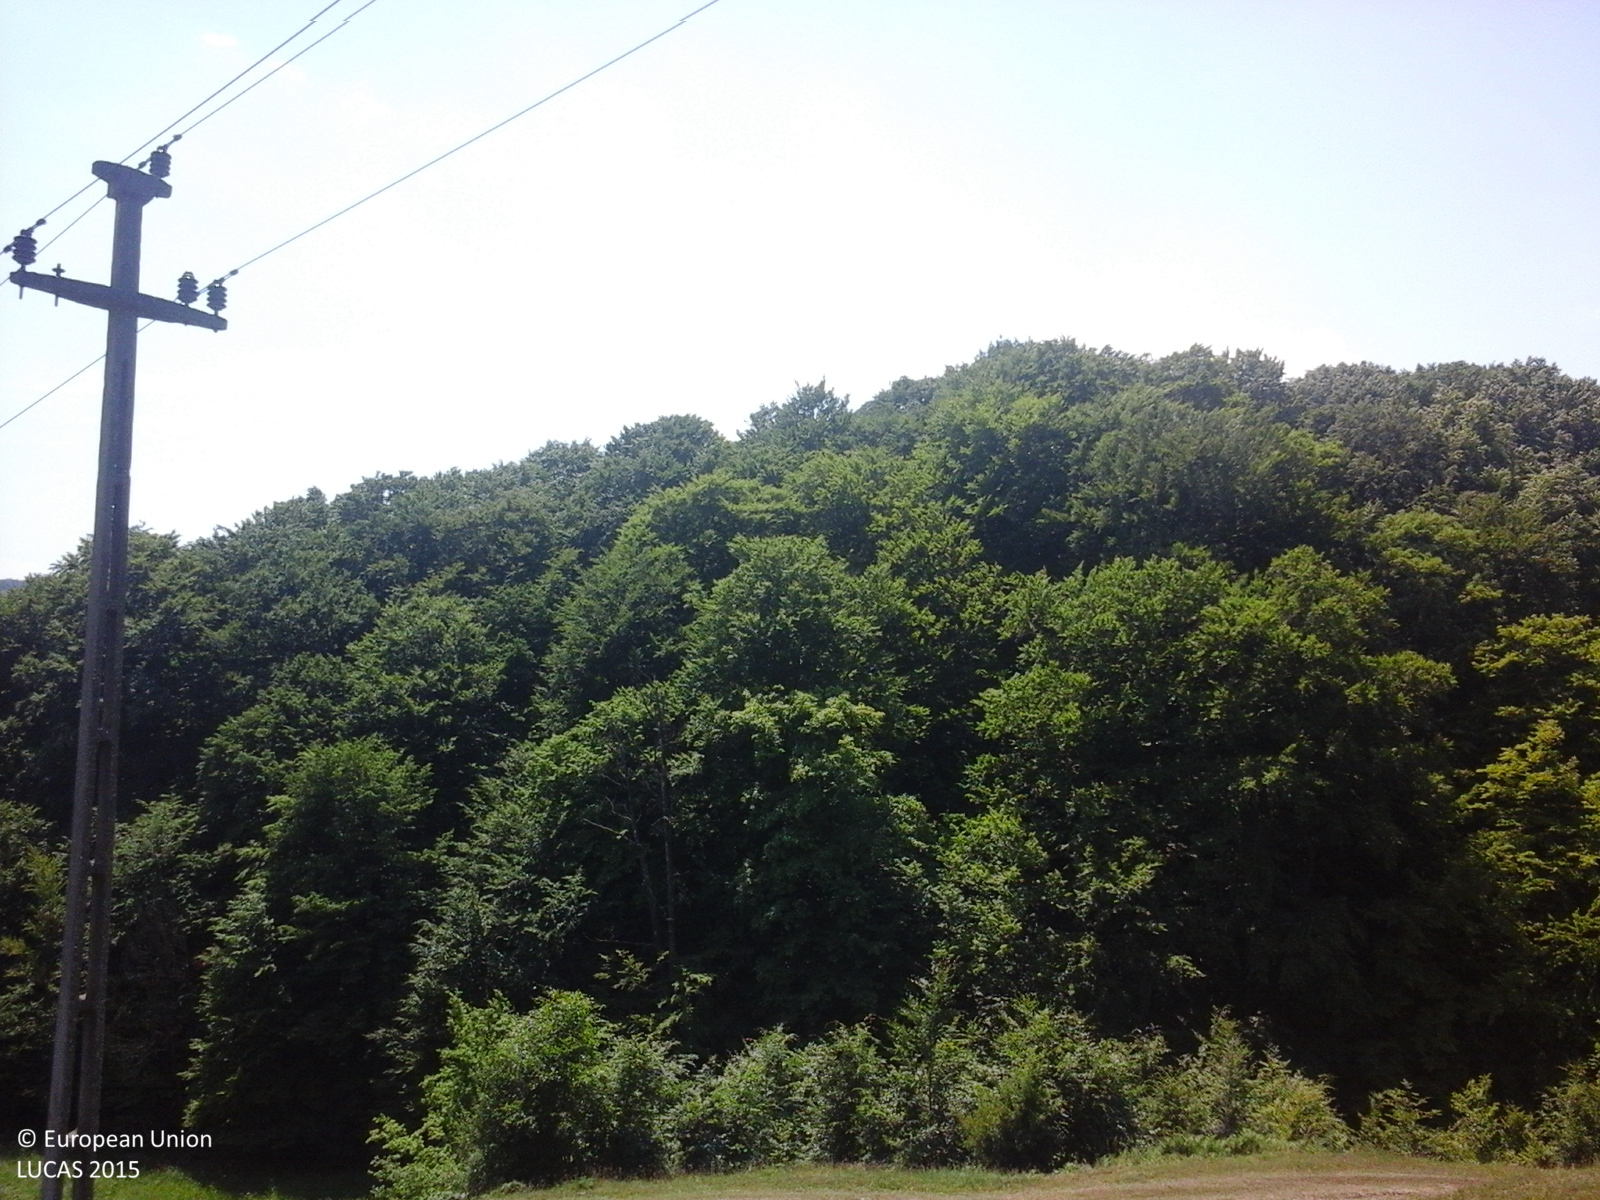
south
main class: Grassland
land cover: Grassland without tree/shrub cover
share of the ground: > 75 %
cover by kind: herbaceous plants 100 %
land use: Agriculture (excluding fallow land and kitchen gardens)
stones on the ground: < 10 %
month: June
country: RO
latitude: 46.6726
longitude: 26.5147
